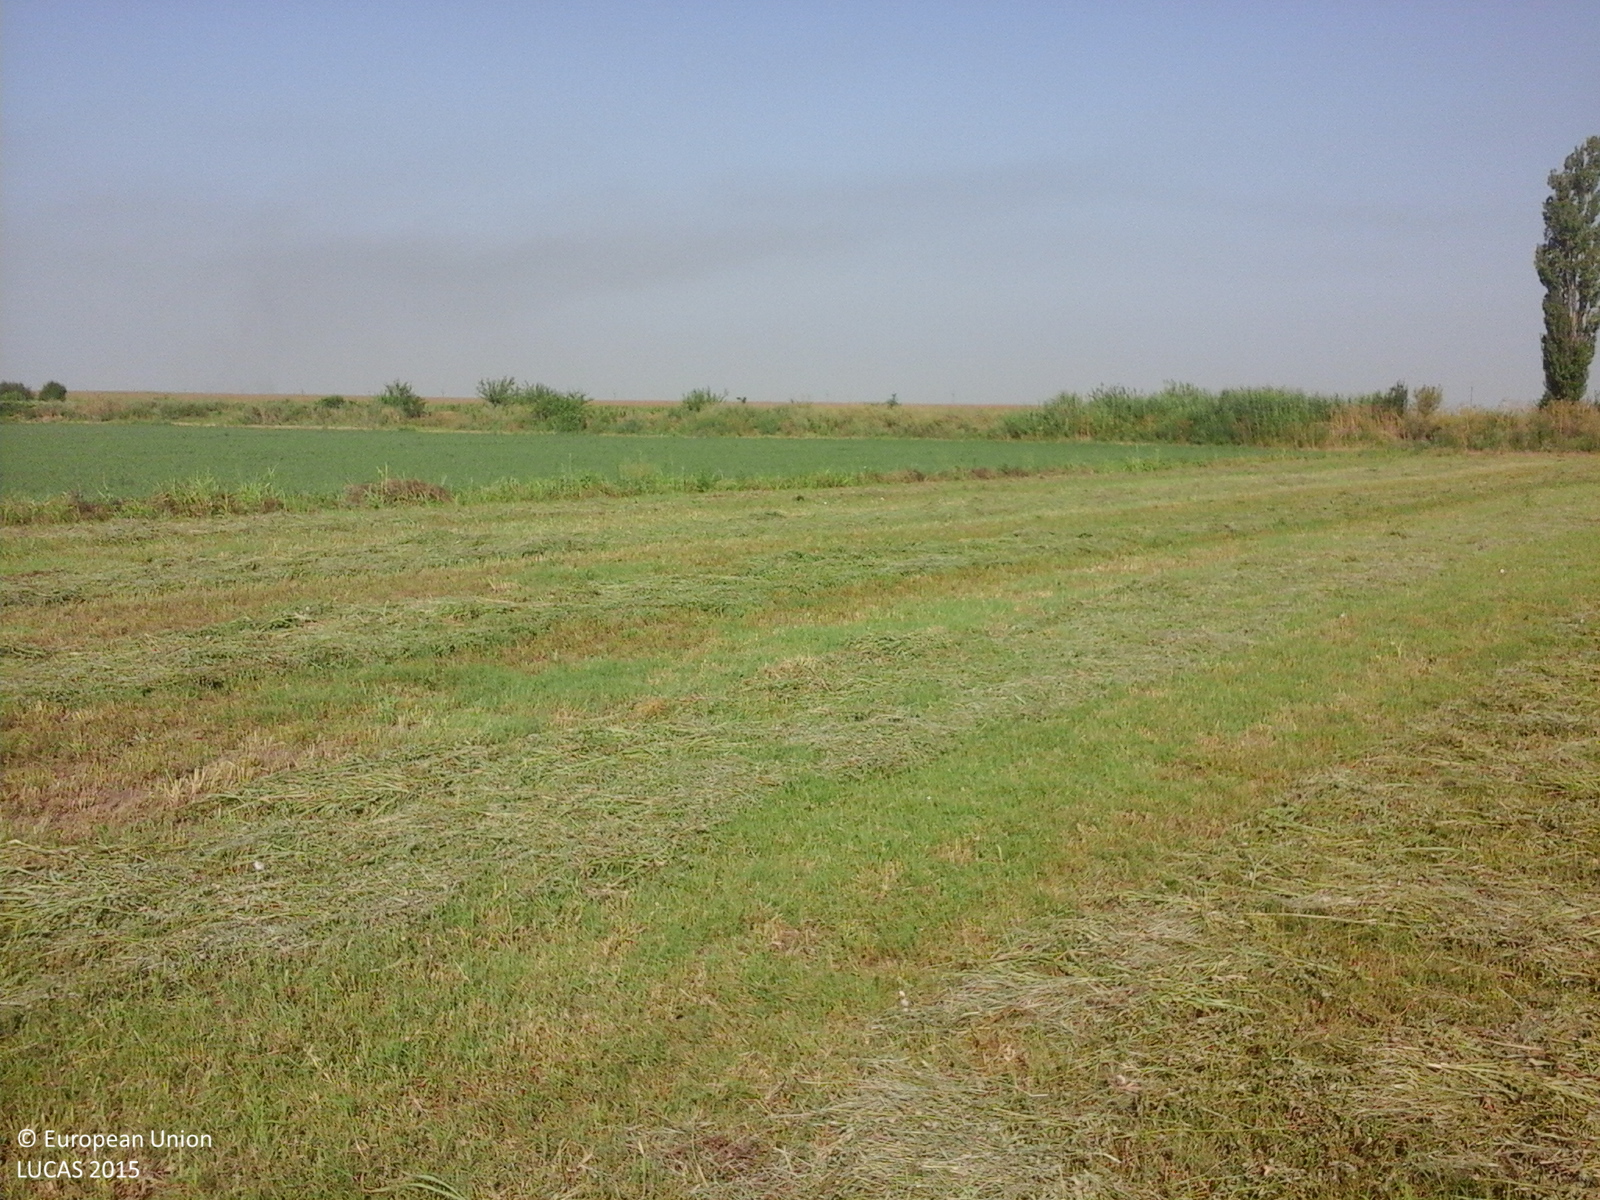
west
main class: Cropland
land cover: Lucerne
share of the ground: > 75 %
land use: Agriculture (excluding fallow land and kitchen gardens)
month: July
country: RO
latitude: 44.1890
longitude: 26.8738
